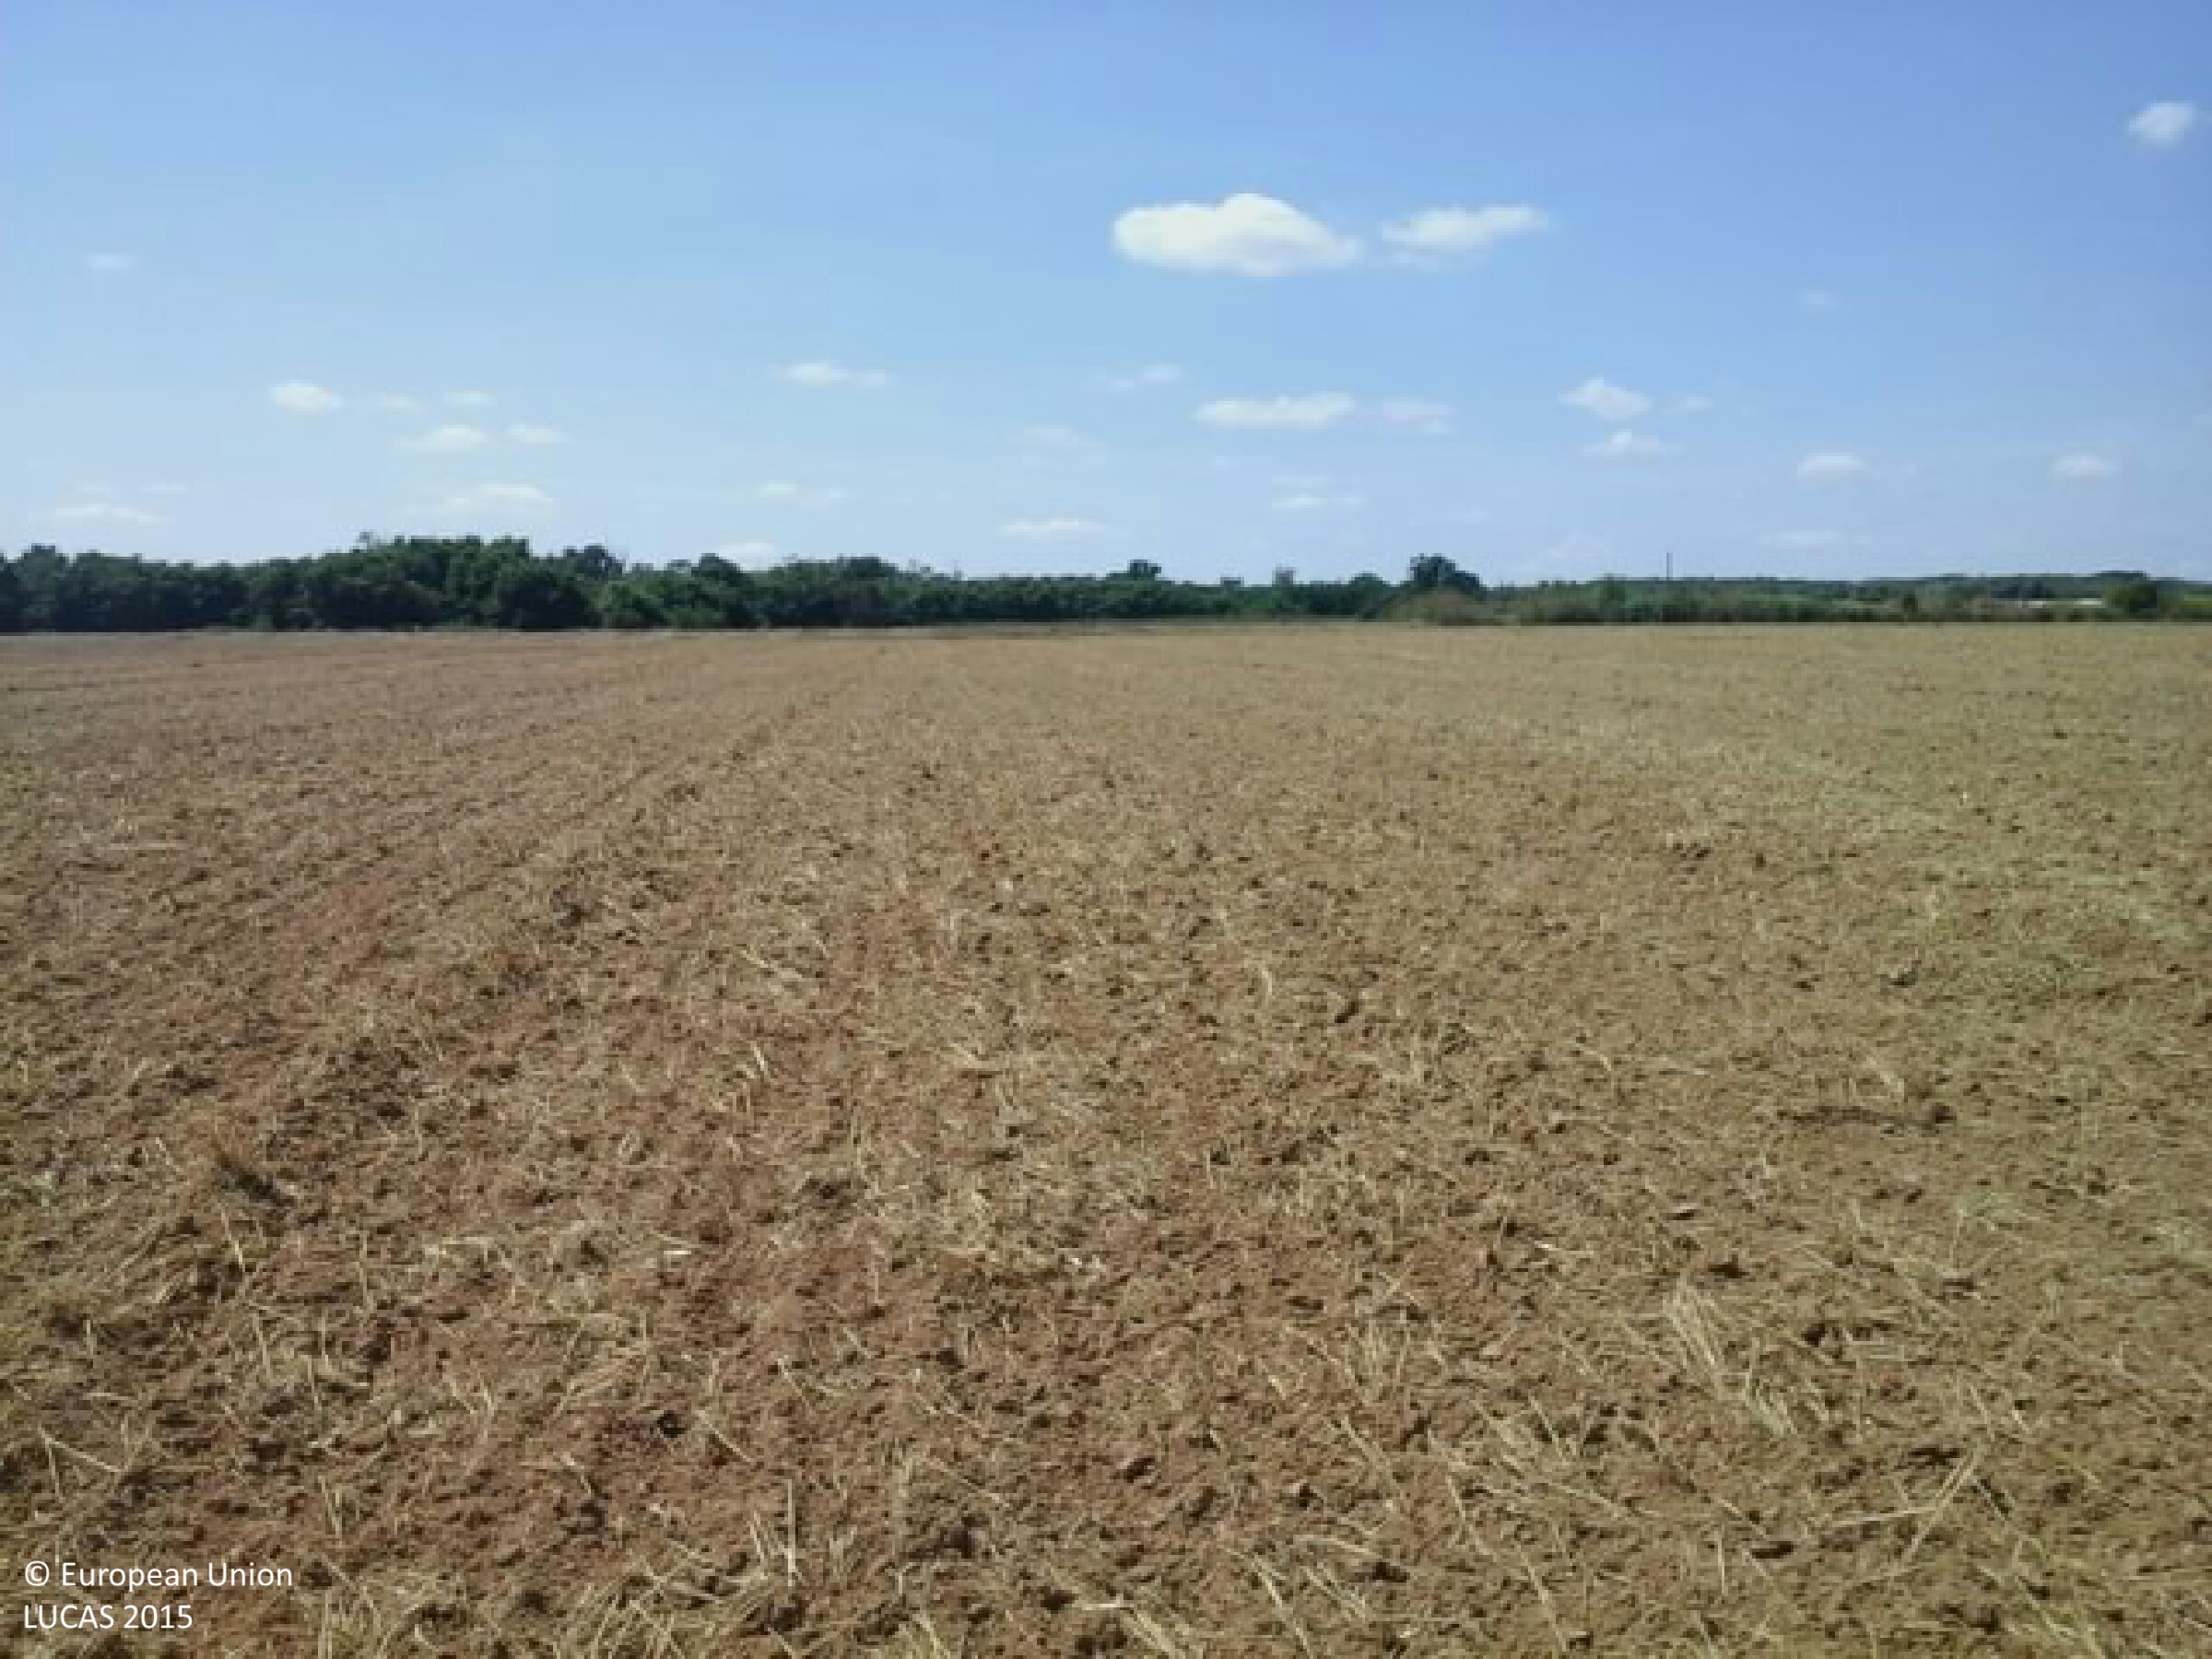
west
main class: Cropland
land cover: Common wheat
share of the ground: < 10 %
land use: Agriculture (excluding fallow land and kitchen gardens)
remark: Harvested field
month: August
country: HU
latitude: 46.5647
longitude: 17.4016
